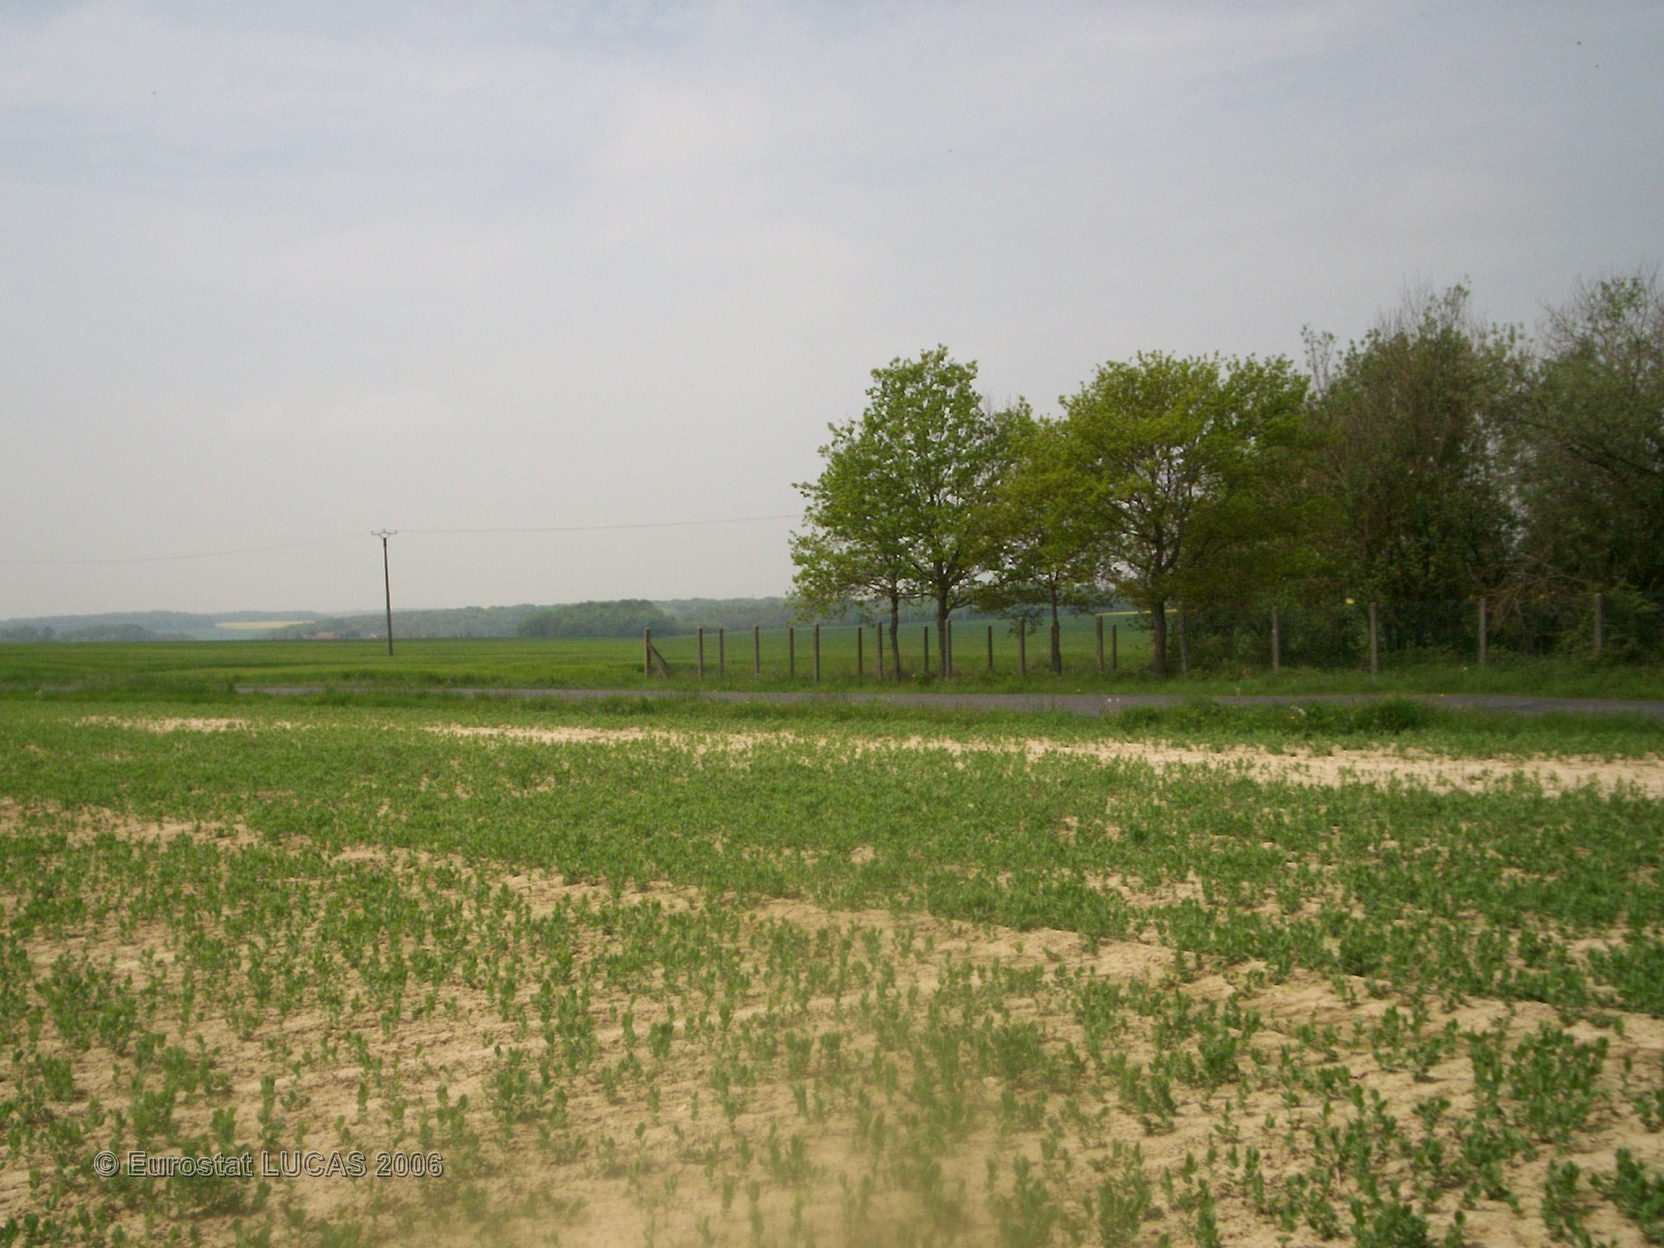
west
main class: Cropland
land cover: Dry pulses
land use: Agriculture (excluding fallow land and kitchen gardens)
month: May
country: FR
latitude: 47.9086
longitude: 2.9690
